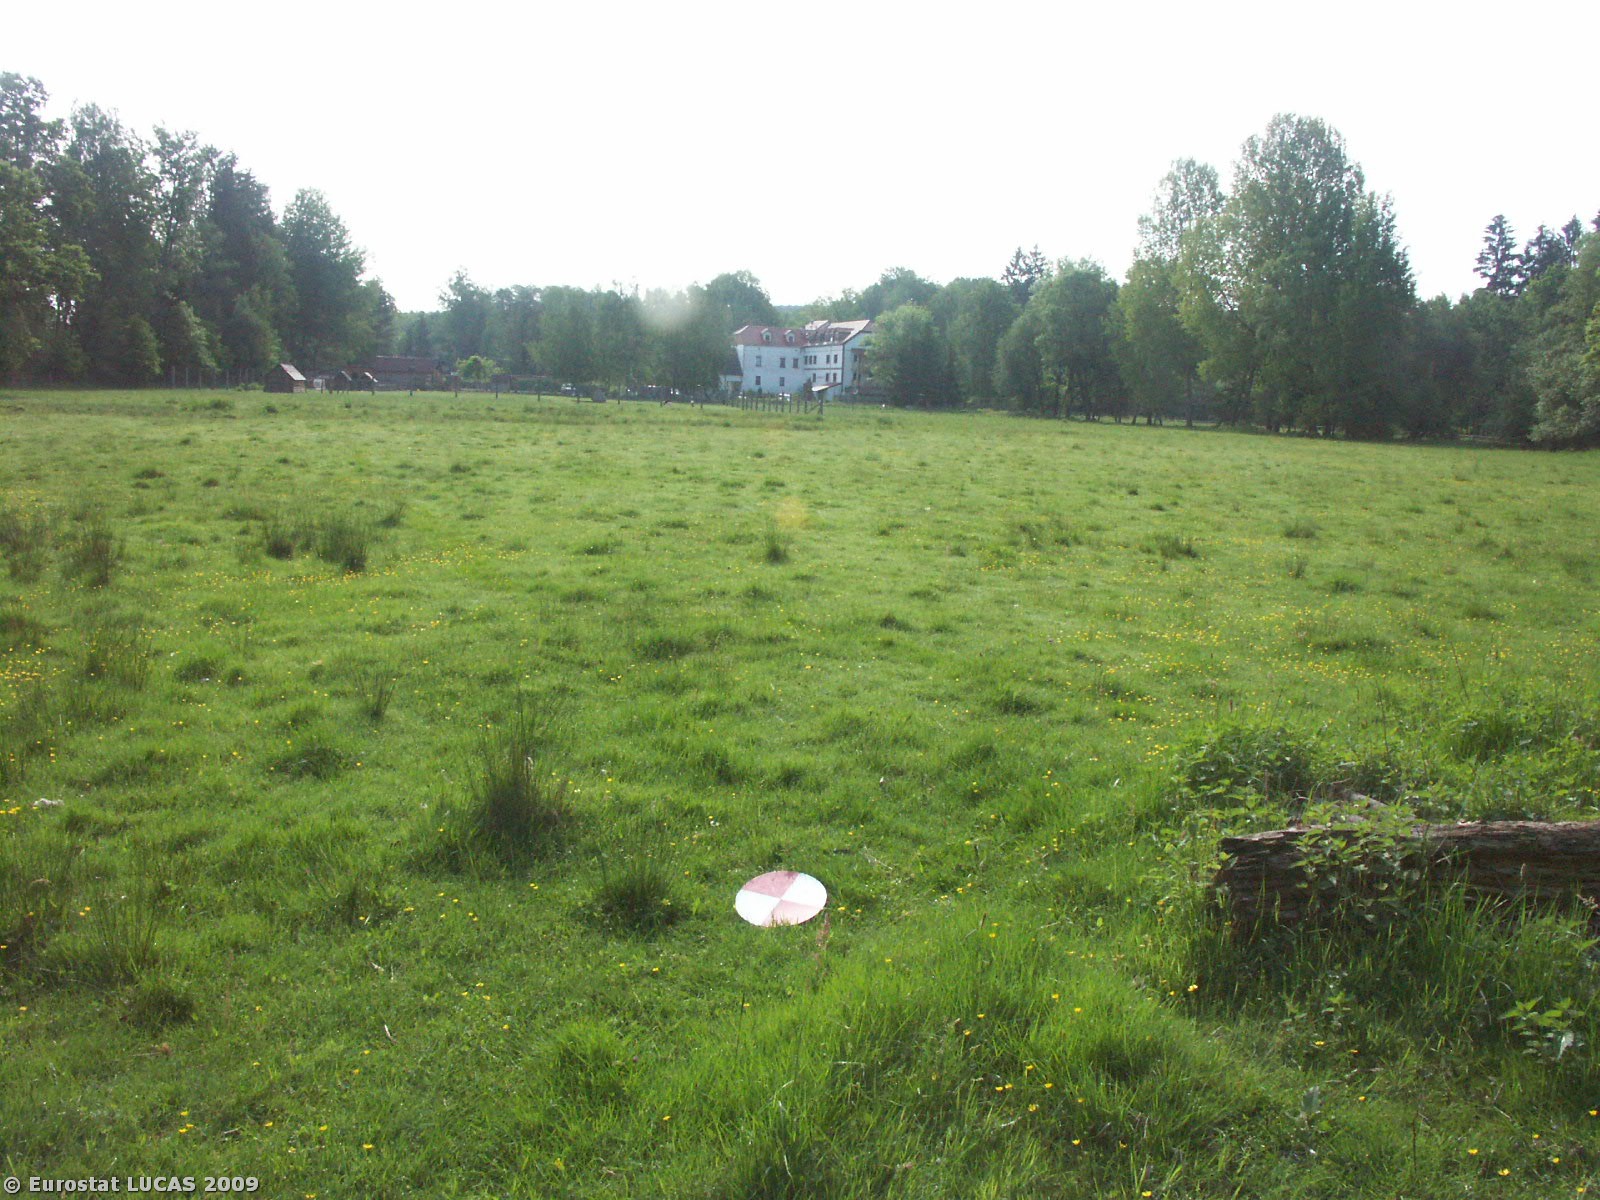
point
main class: Grassland
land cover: Grassland without tree/shrub cover
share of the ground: > 75 %
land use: Agriculture (excluding fallow land and kitchen gardens)
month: May
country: CZ
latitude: 48.8835
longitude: 14.6242
